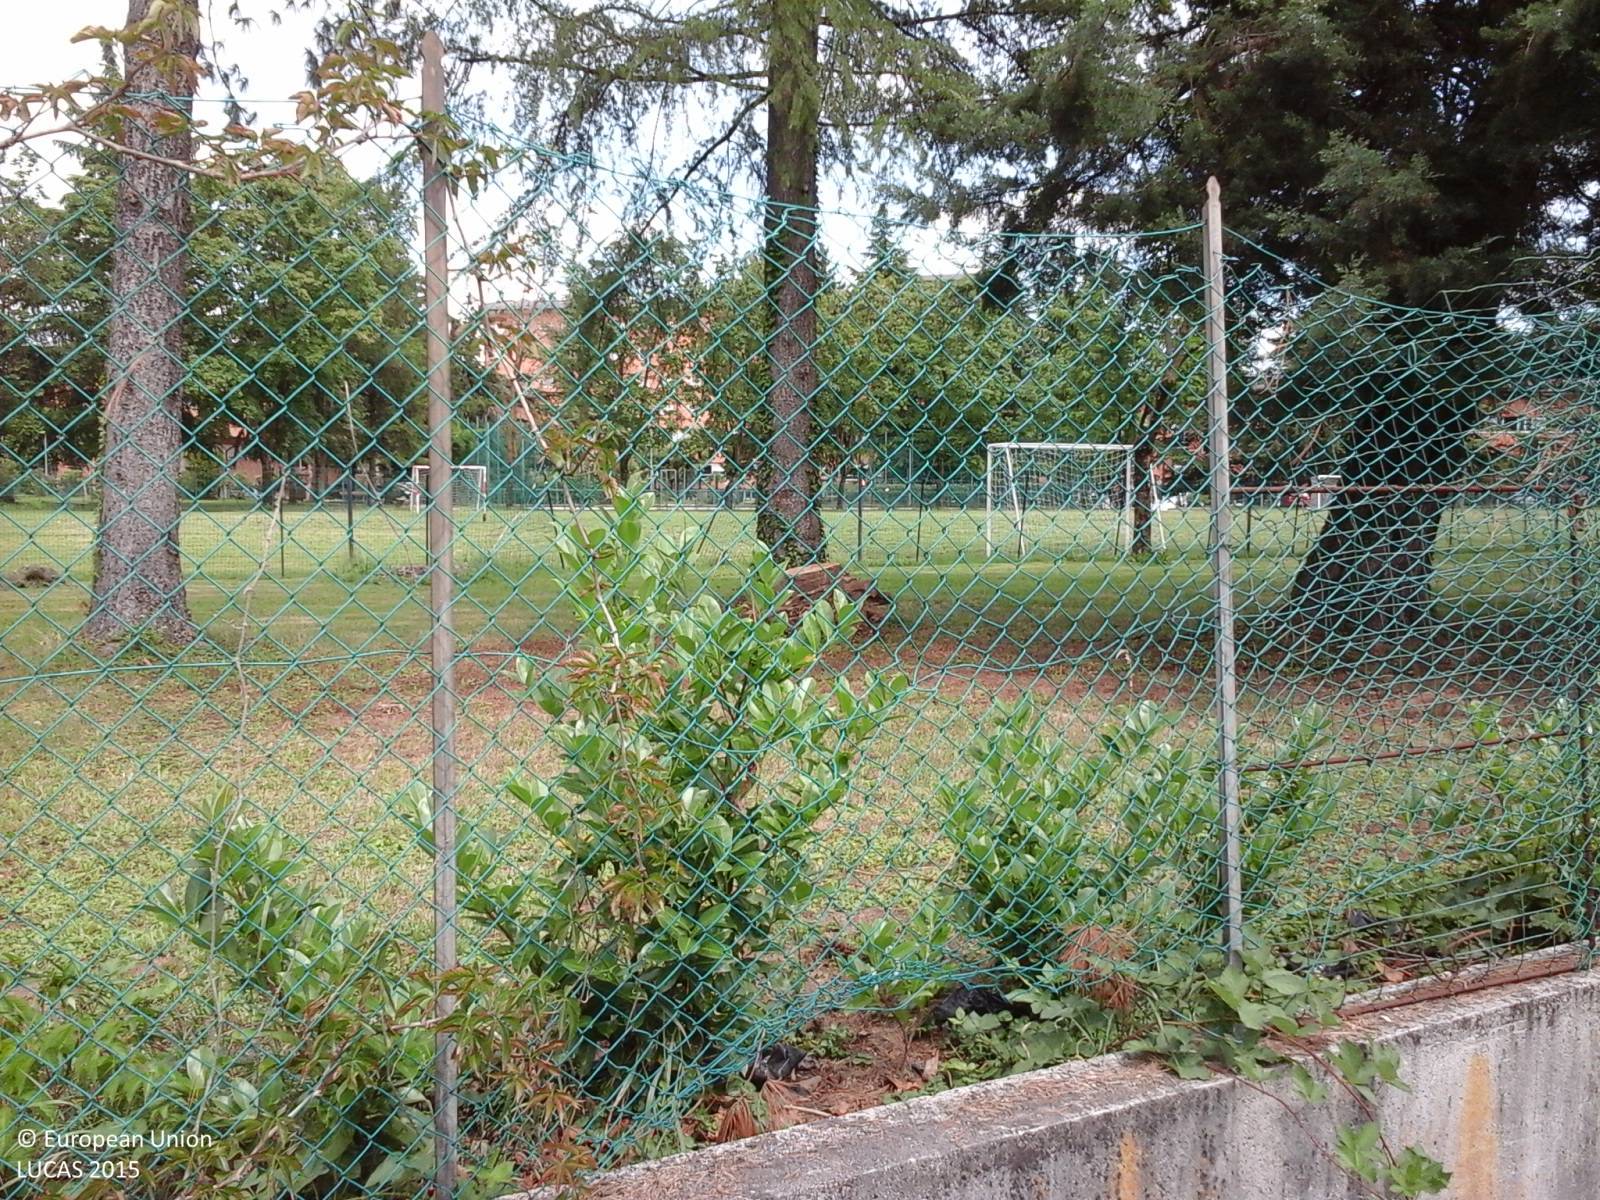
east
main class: Grassland
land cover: Grassland without tree/shrub cover
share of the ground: > 75 %
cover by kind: herbaceous plants 100 %
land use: Sport
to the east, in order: Grassland without tree/shrub cover; Lines of trees; Artificial constructions in urban areas
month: June
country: IT
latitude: 46.0685
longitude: 13.2156
